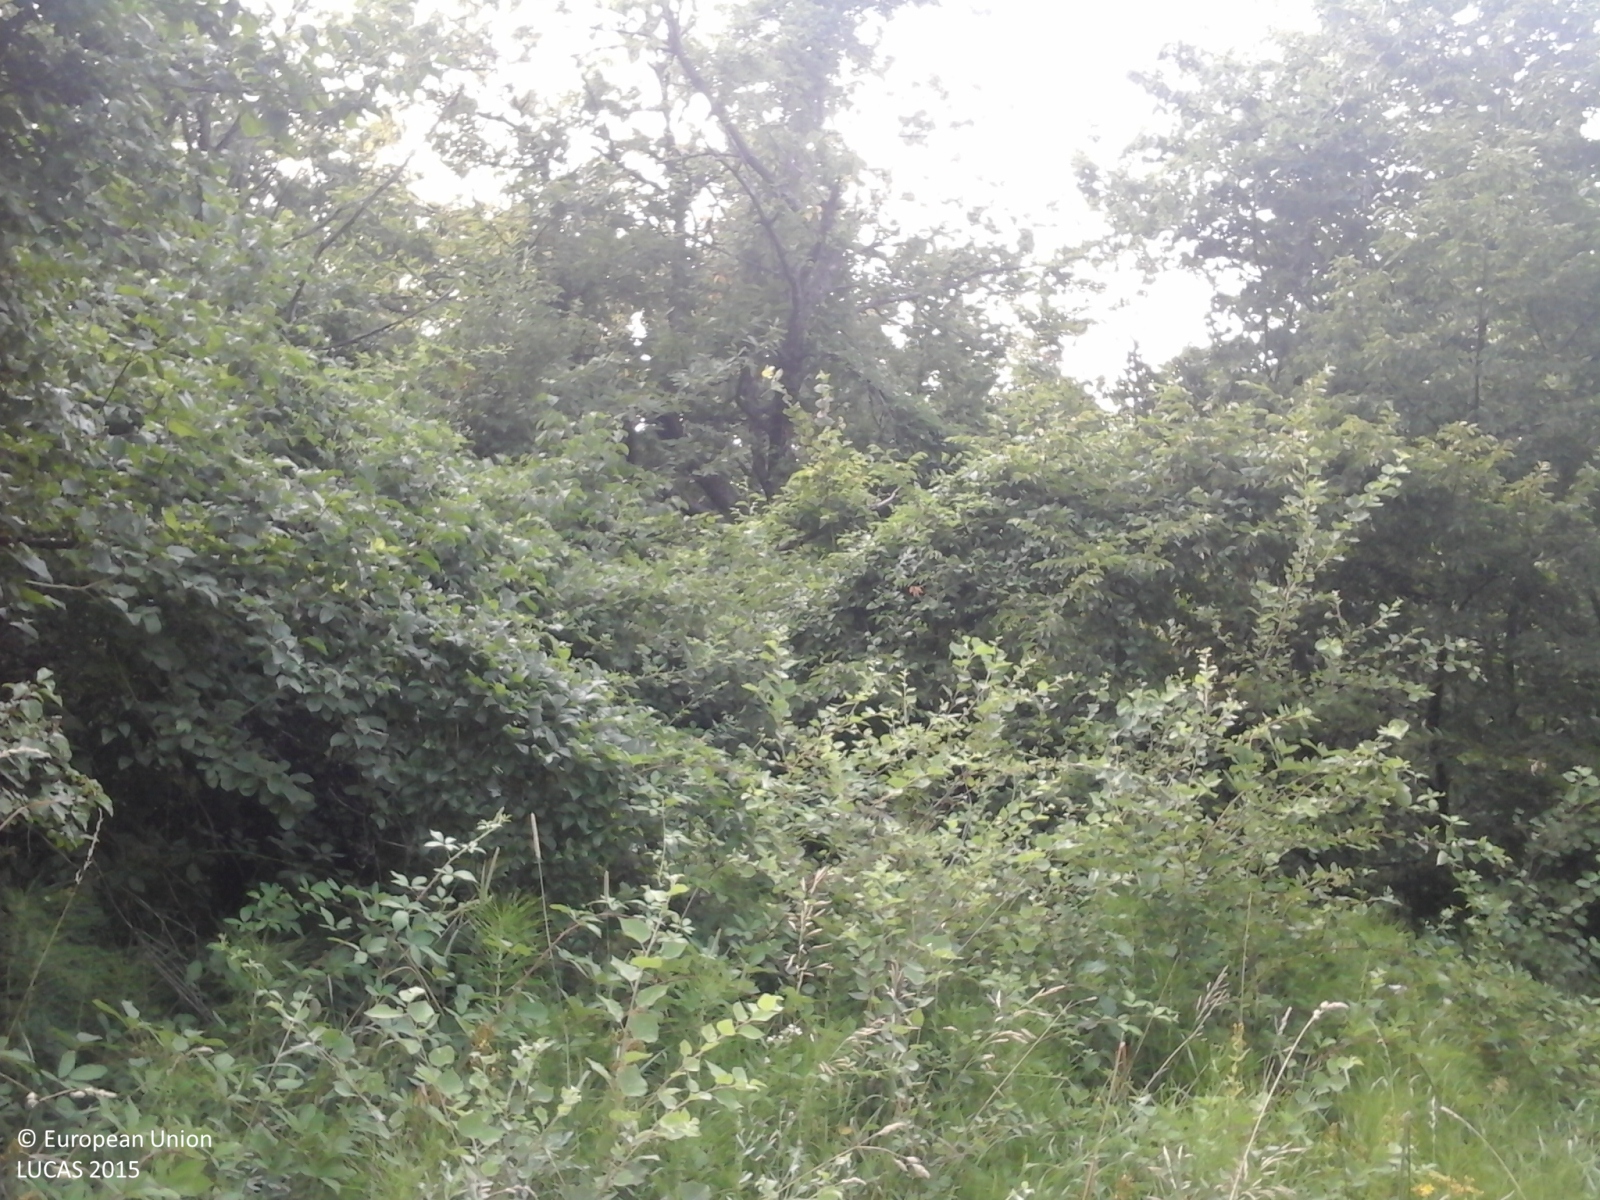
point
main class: Woodland
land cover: Broadleaved woodland
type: thermophilous deciduous forest
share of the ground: > 75 %
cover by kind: broadleaved forest trees 100 %
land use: Forestry
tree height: > 5 m
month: July
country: IT
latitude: 44.3487
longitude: 10.6133
